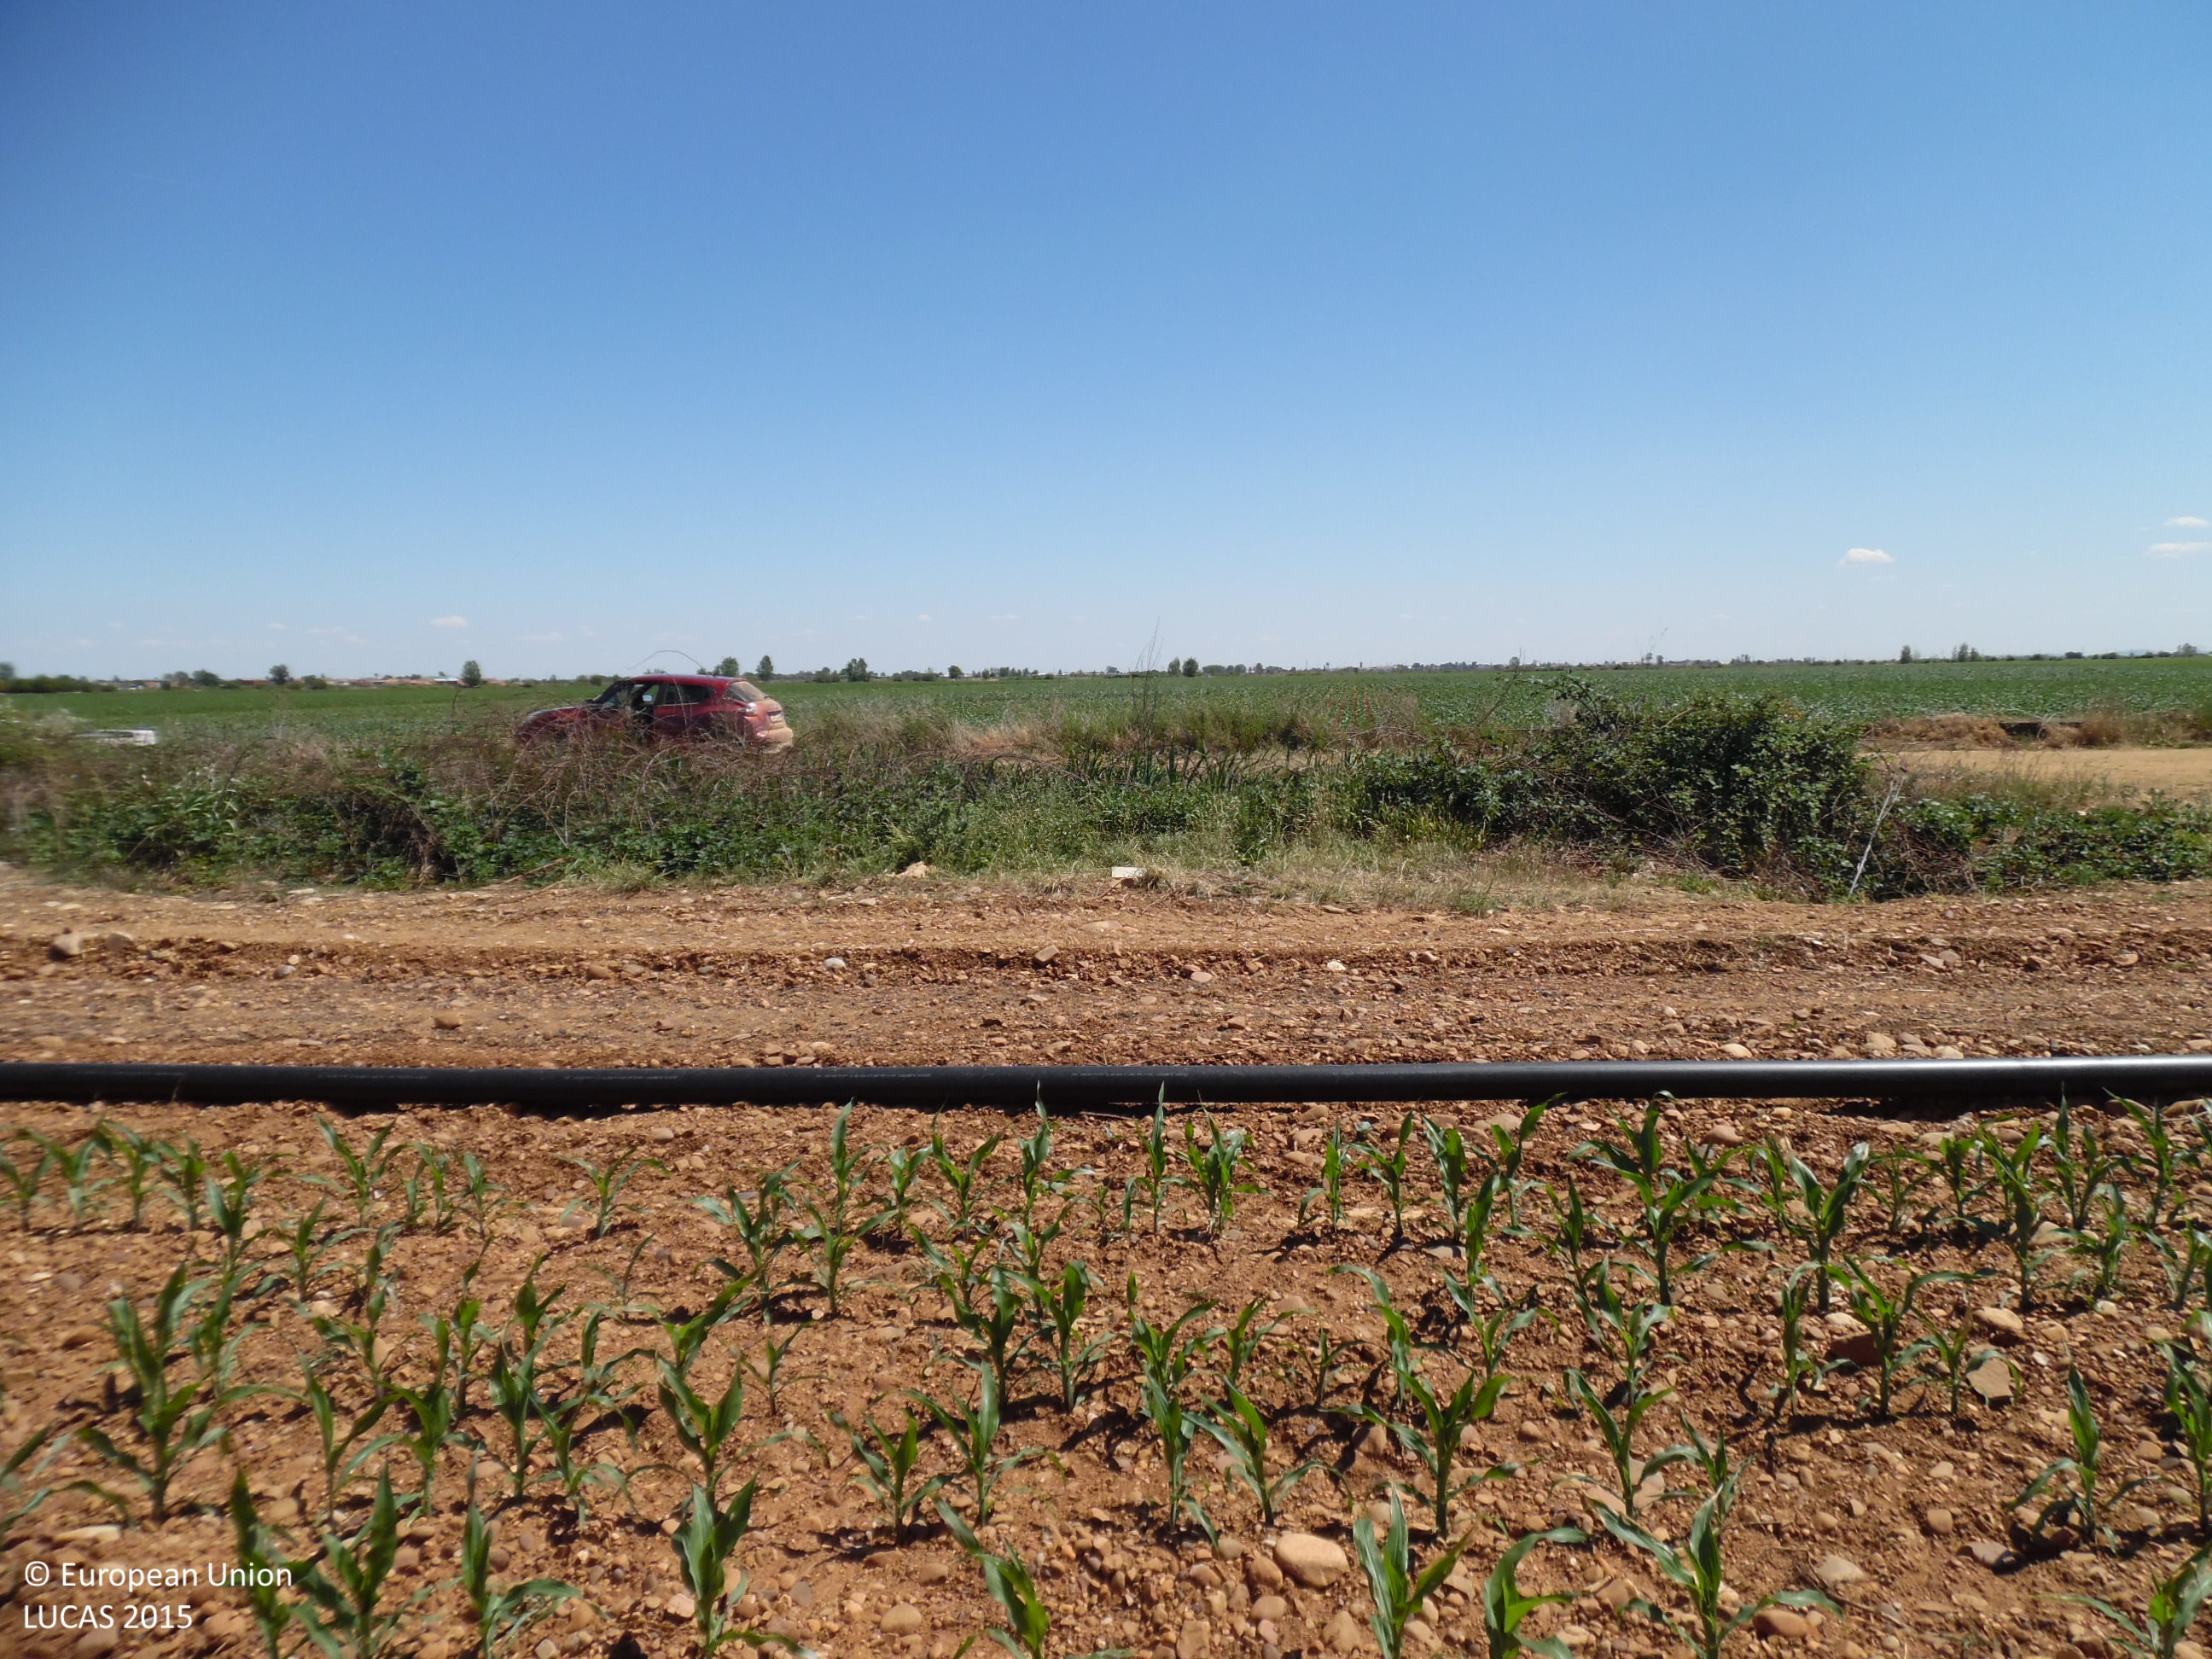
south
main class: Cropland
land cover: Maize
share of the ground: 50 - 75 %
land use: Agriculture (excluding fallow land and kitchen gardens)
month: June
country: ES
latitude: 42.4029
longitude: -5.7597
